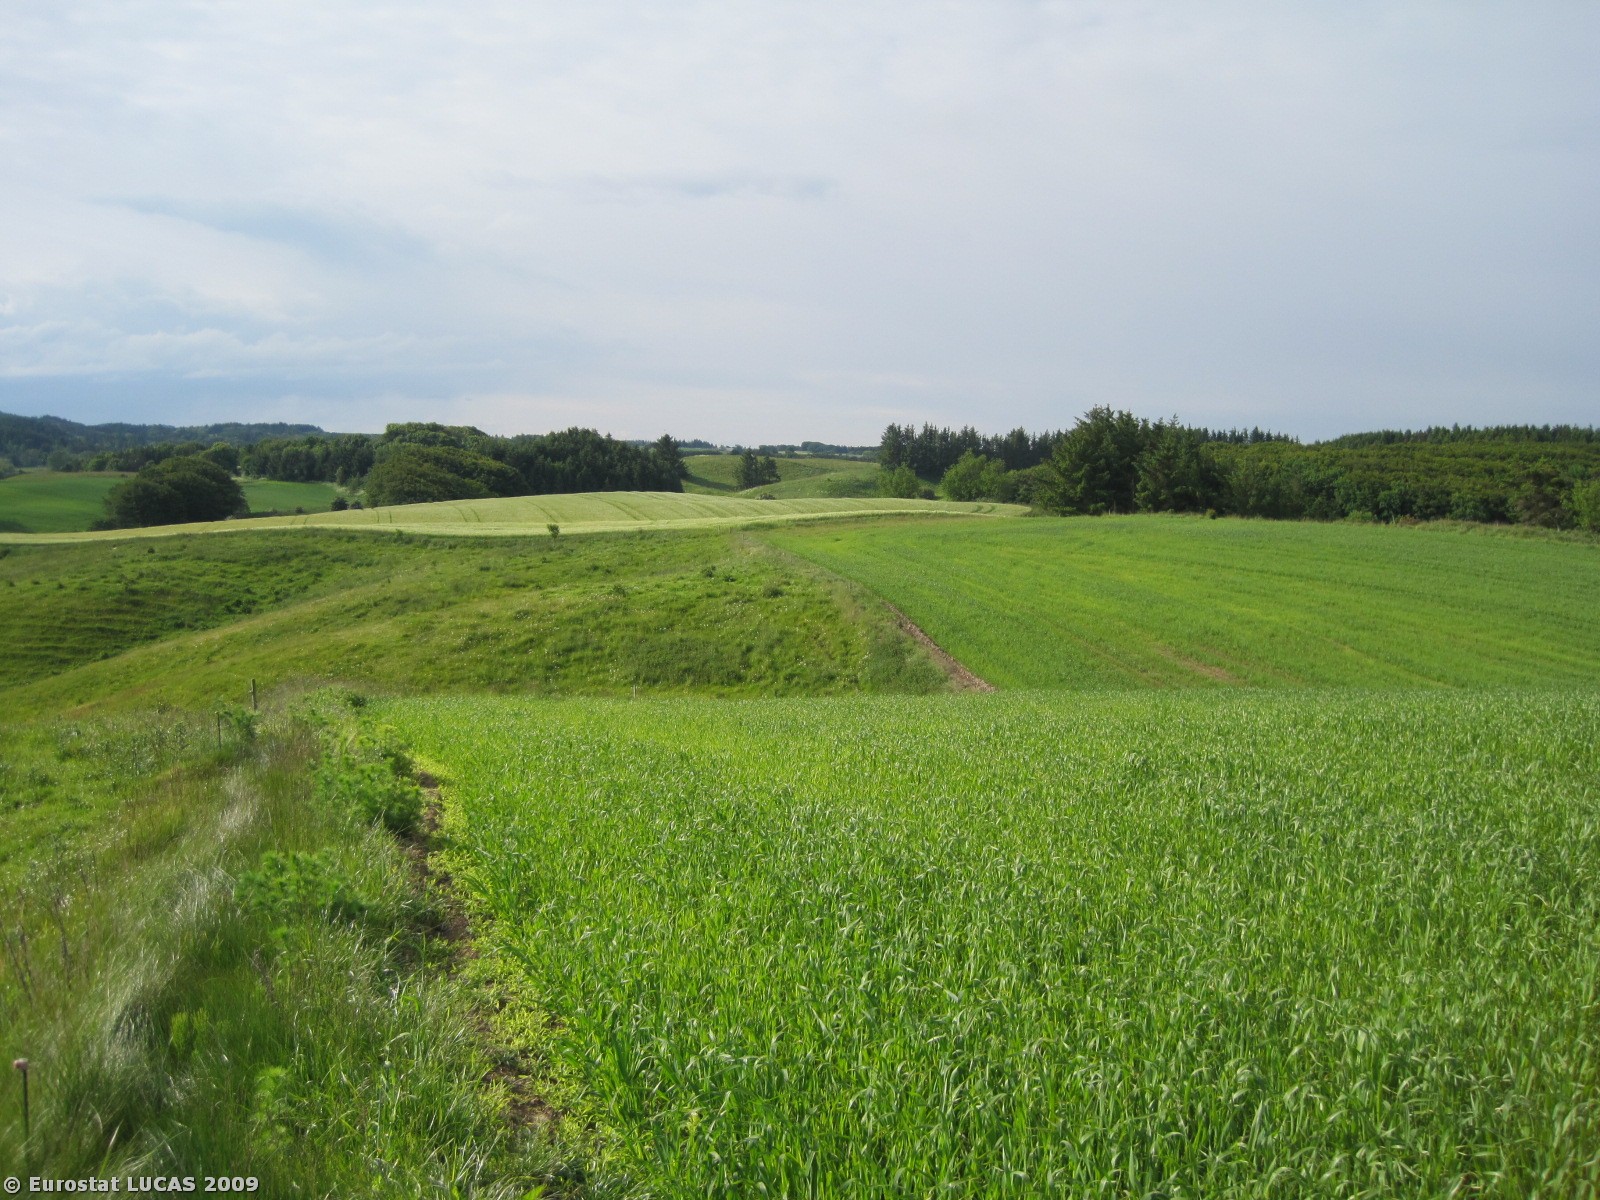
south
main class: Grassland
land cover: Grassland without tree/shrub cover
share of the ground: > 75 %
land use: Agriculture (excluding fallow land and kitchen gardens)
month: June
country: DK
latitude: 57.5361
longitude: 10.0500
